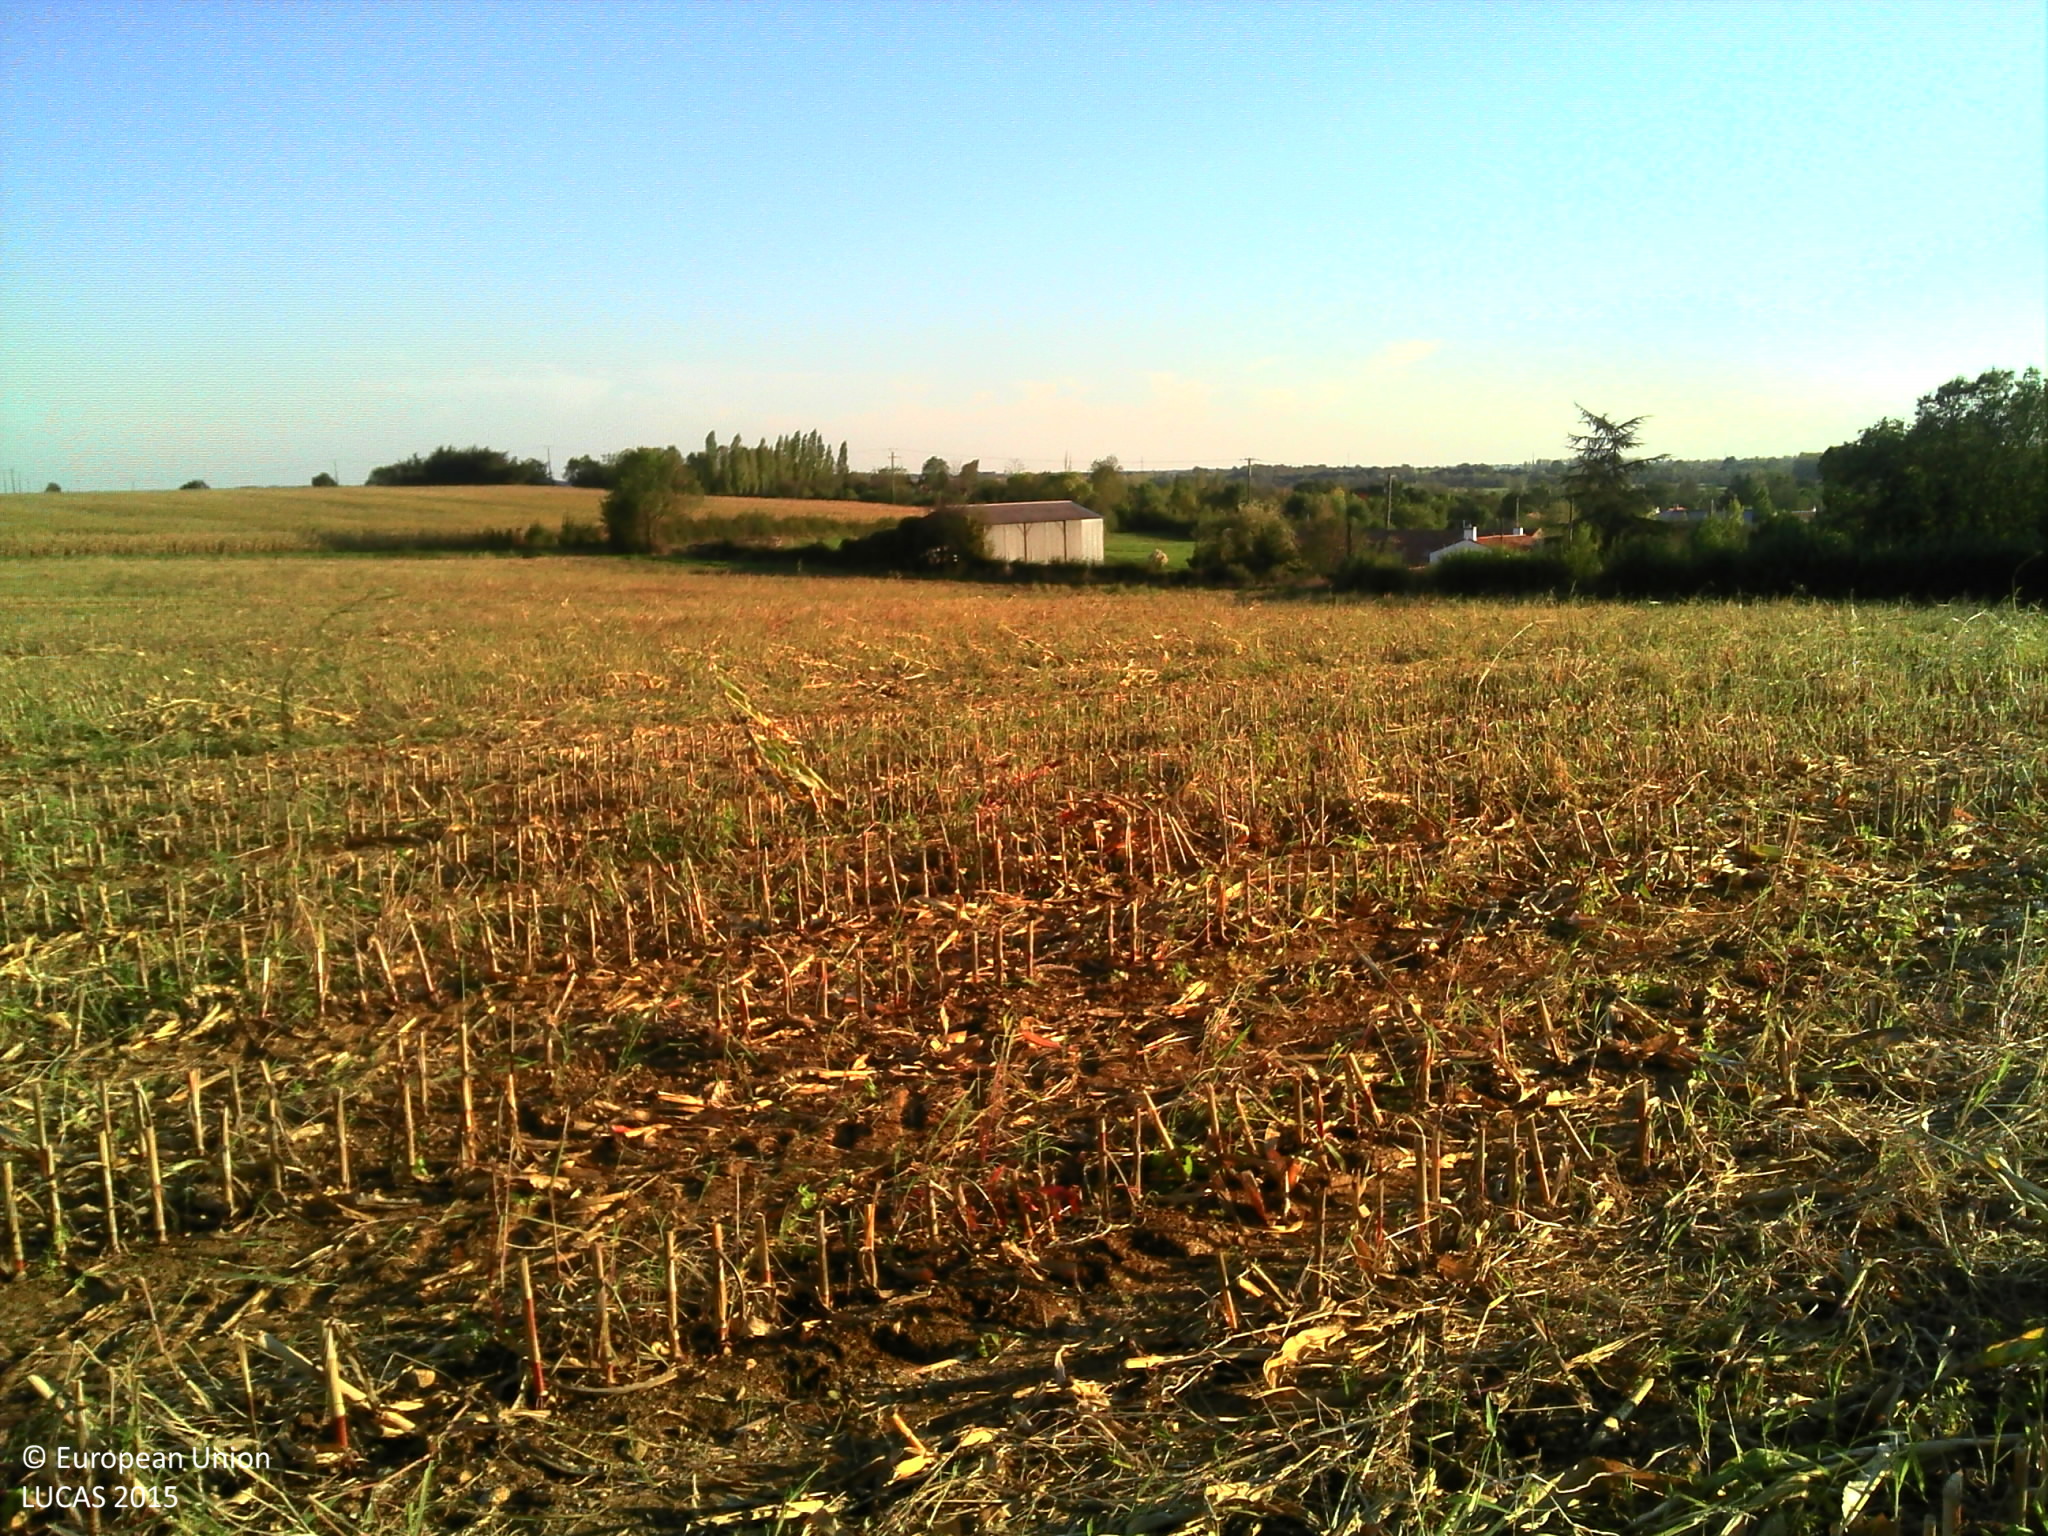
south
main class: Cropland
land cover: Maize
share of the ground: 10 - 25 %
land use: Agriculture (excluding fallow land and kitchen gardens)
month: September
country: FR
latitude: 46.4978
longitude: -1.2798
